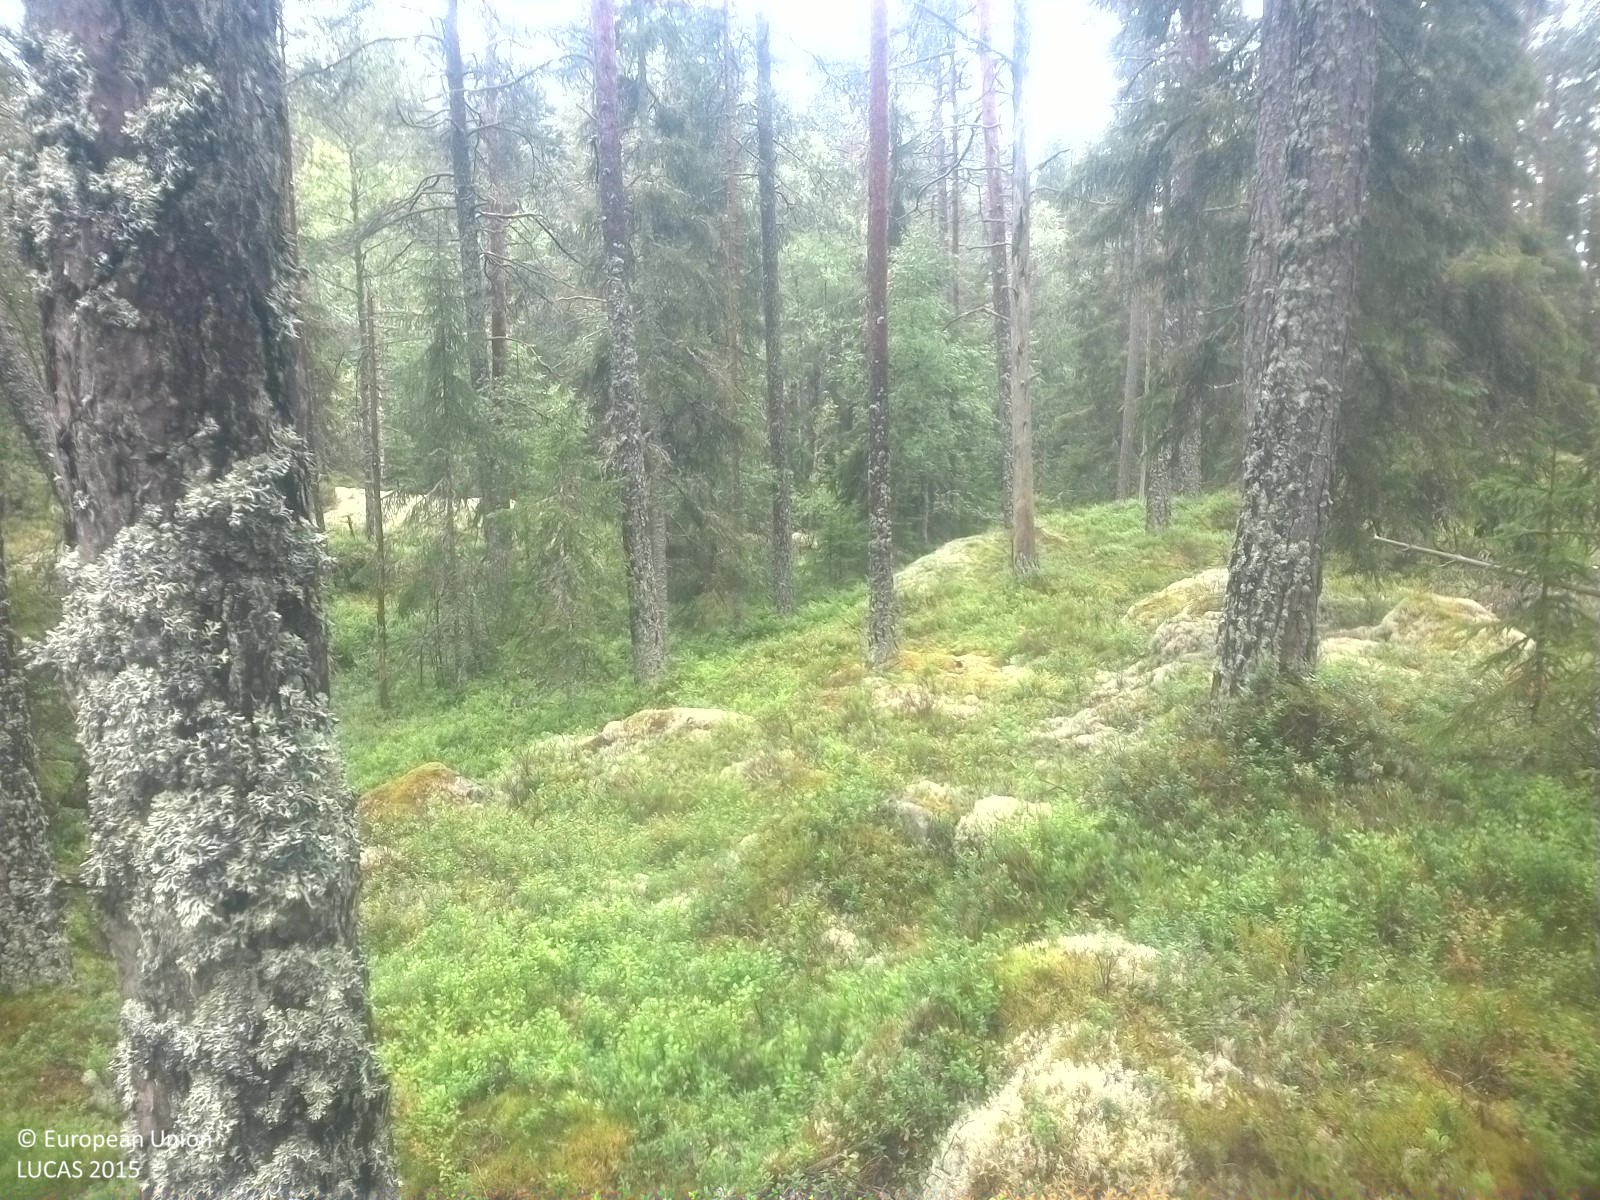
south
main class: Woodland
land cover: Pine dominated coniferous woodland
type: boreal forest
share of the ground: 10 - 25 %
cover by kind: herbaceous plants 60 %, coniferous forest trees 20 %, shrubs 10 %, lichens and mosses 10 %
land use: Forestry
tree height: > 5 m
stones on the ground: 25 - 50 %
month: July
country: SE
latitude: 58.7707
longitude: 15.1289
